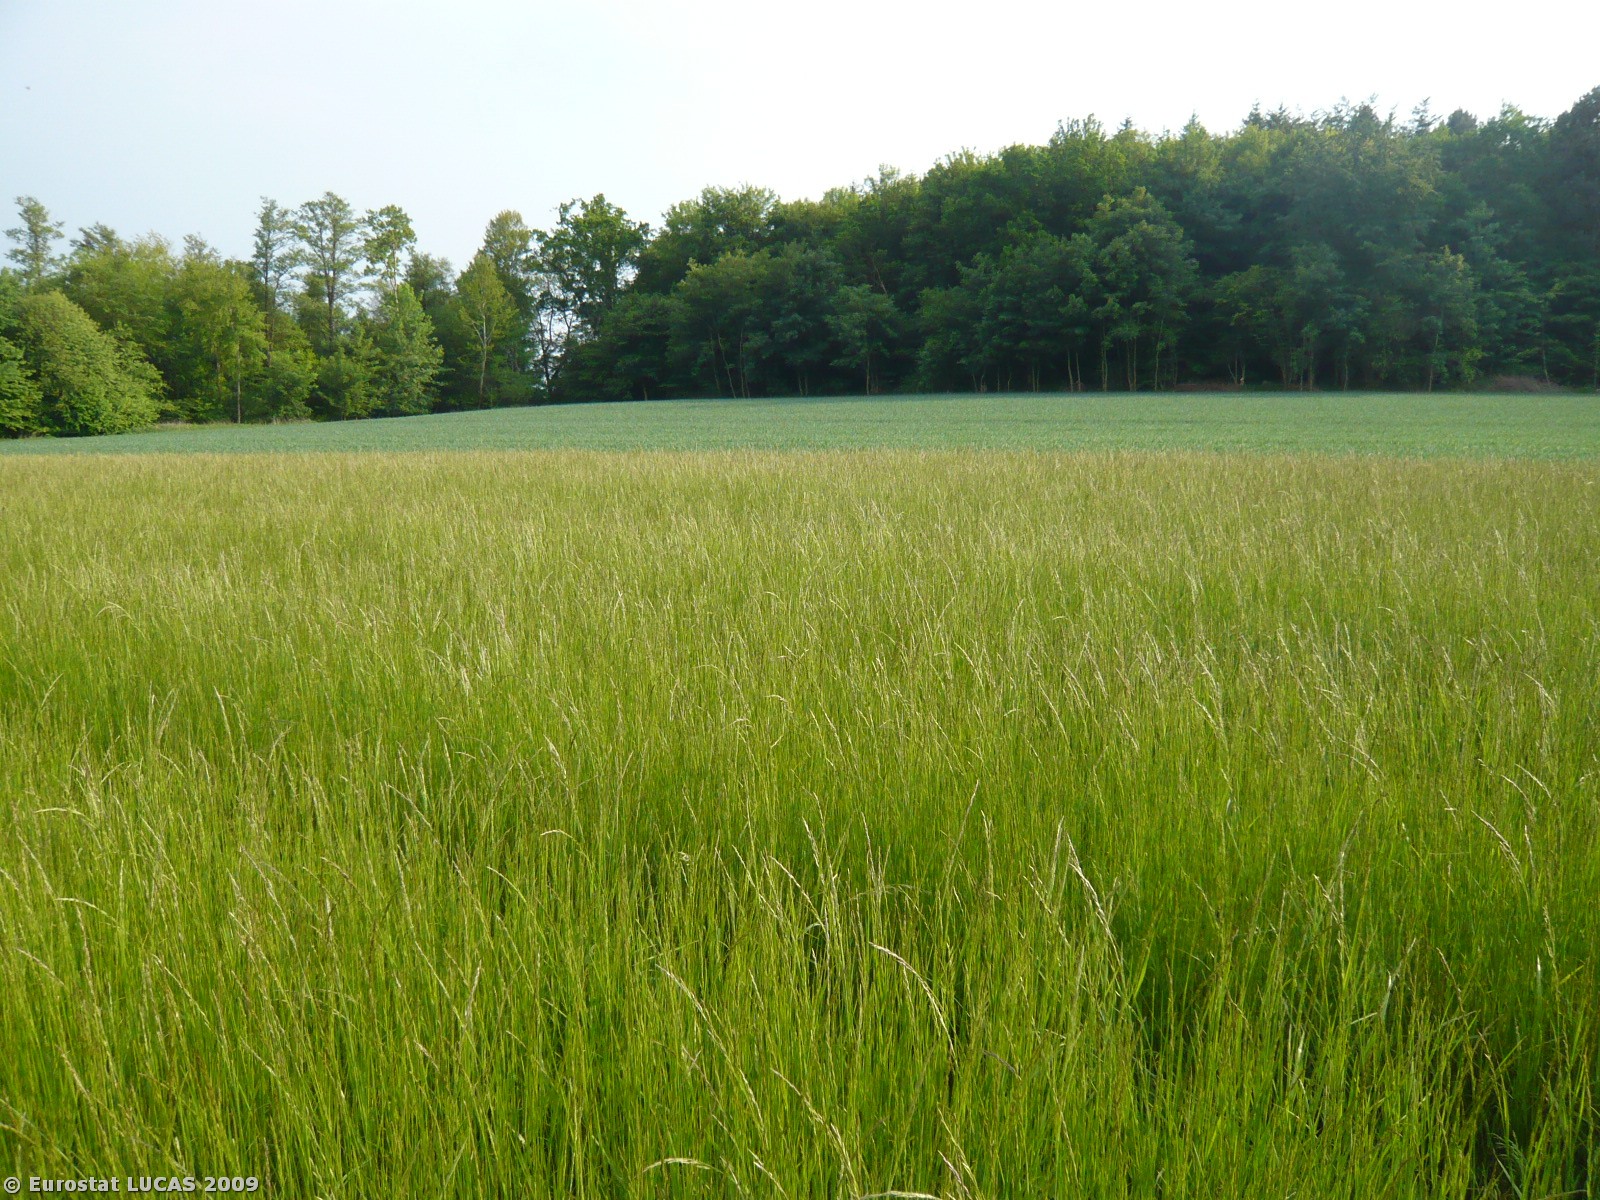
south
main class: Grassland
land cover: Grassland without tree/shrub cover
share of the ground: > 75 %
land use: Agriculture (excluding fallow land and kitchen gardens)
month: May
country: DK
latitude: 55.2059
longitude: 11.6801
